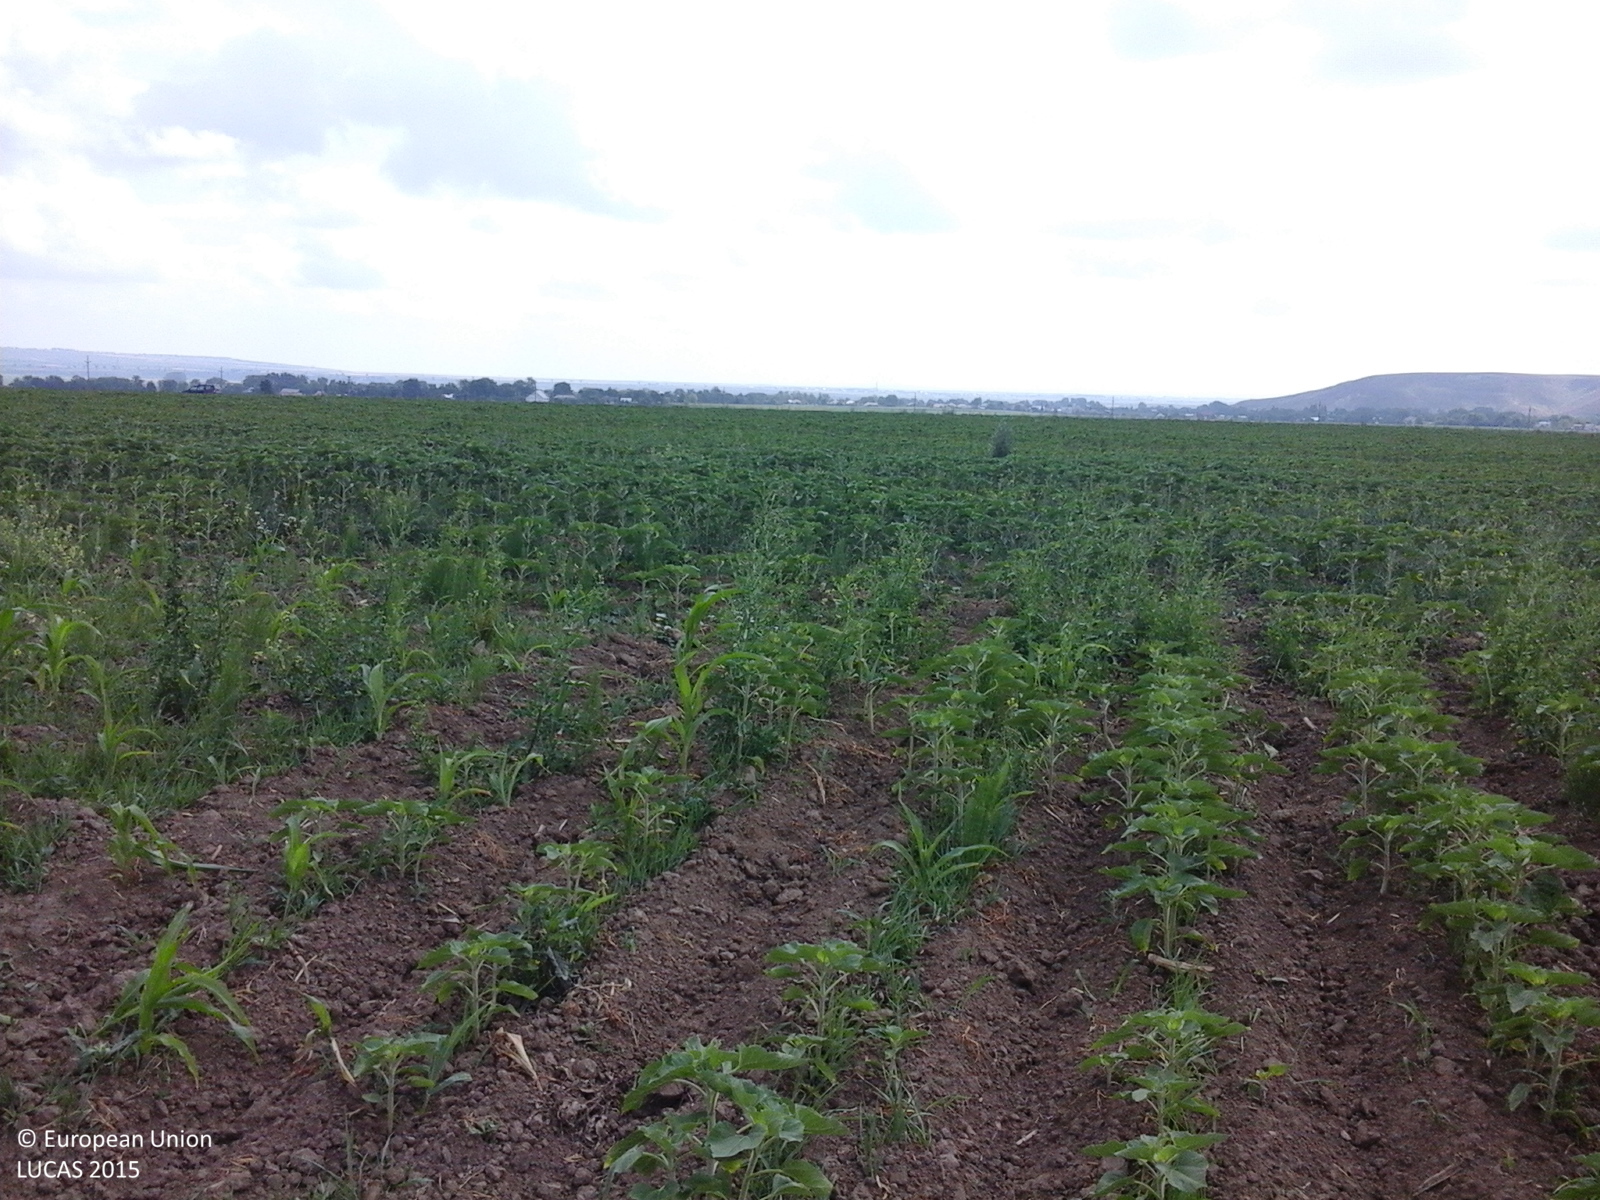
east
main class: Cropland
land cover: Sunflower
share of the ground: 25 - 50 %
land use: Agriculture (excluding fallow land and kitchen gardens)
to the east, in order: Sunflower; Grass margins; Paved roads, cycling and walking lanes; Grass margins; Maize; Sunflower; Oats; Maize
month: June
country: RO
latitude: 47.0789
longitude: 26.6183
